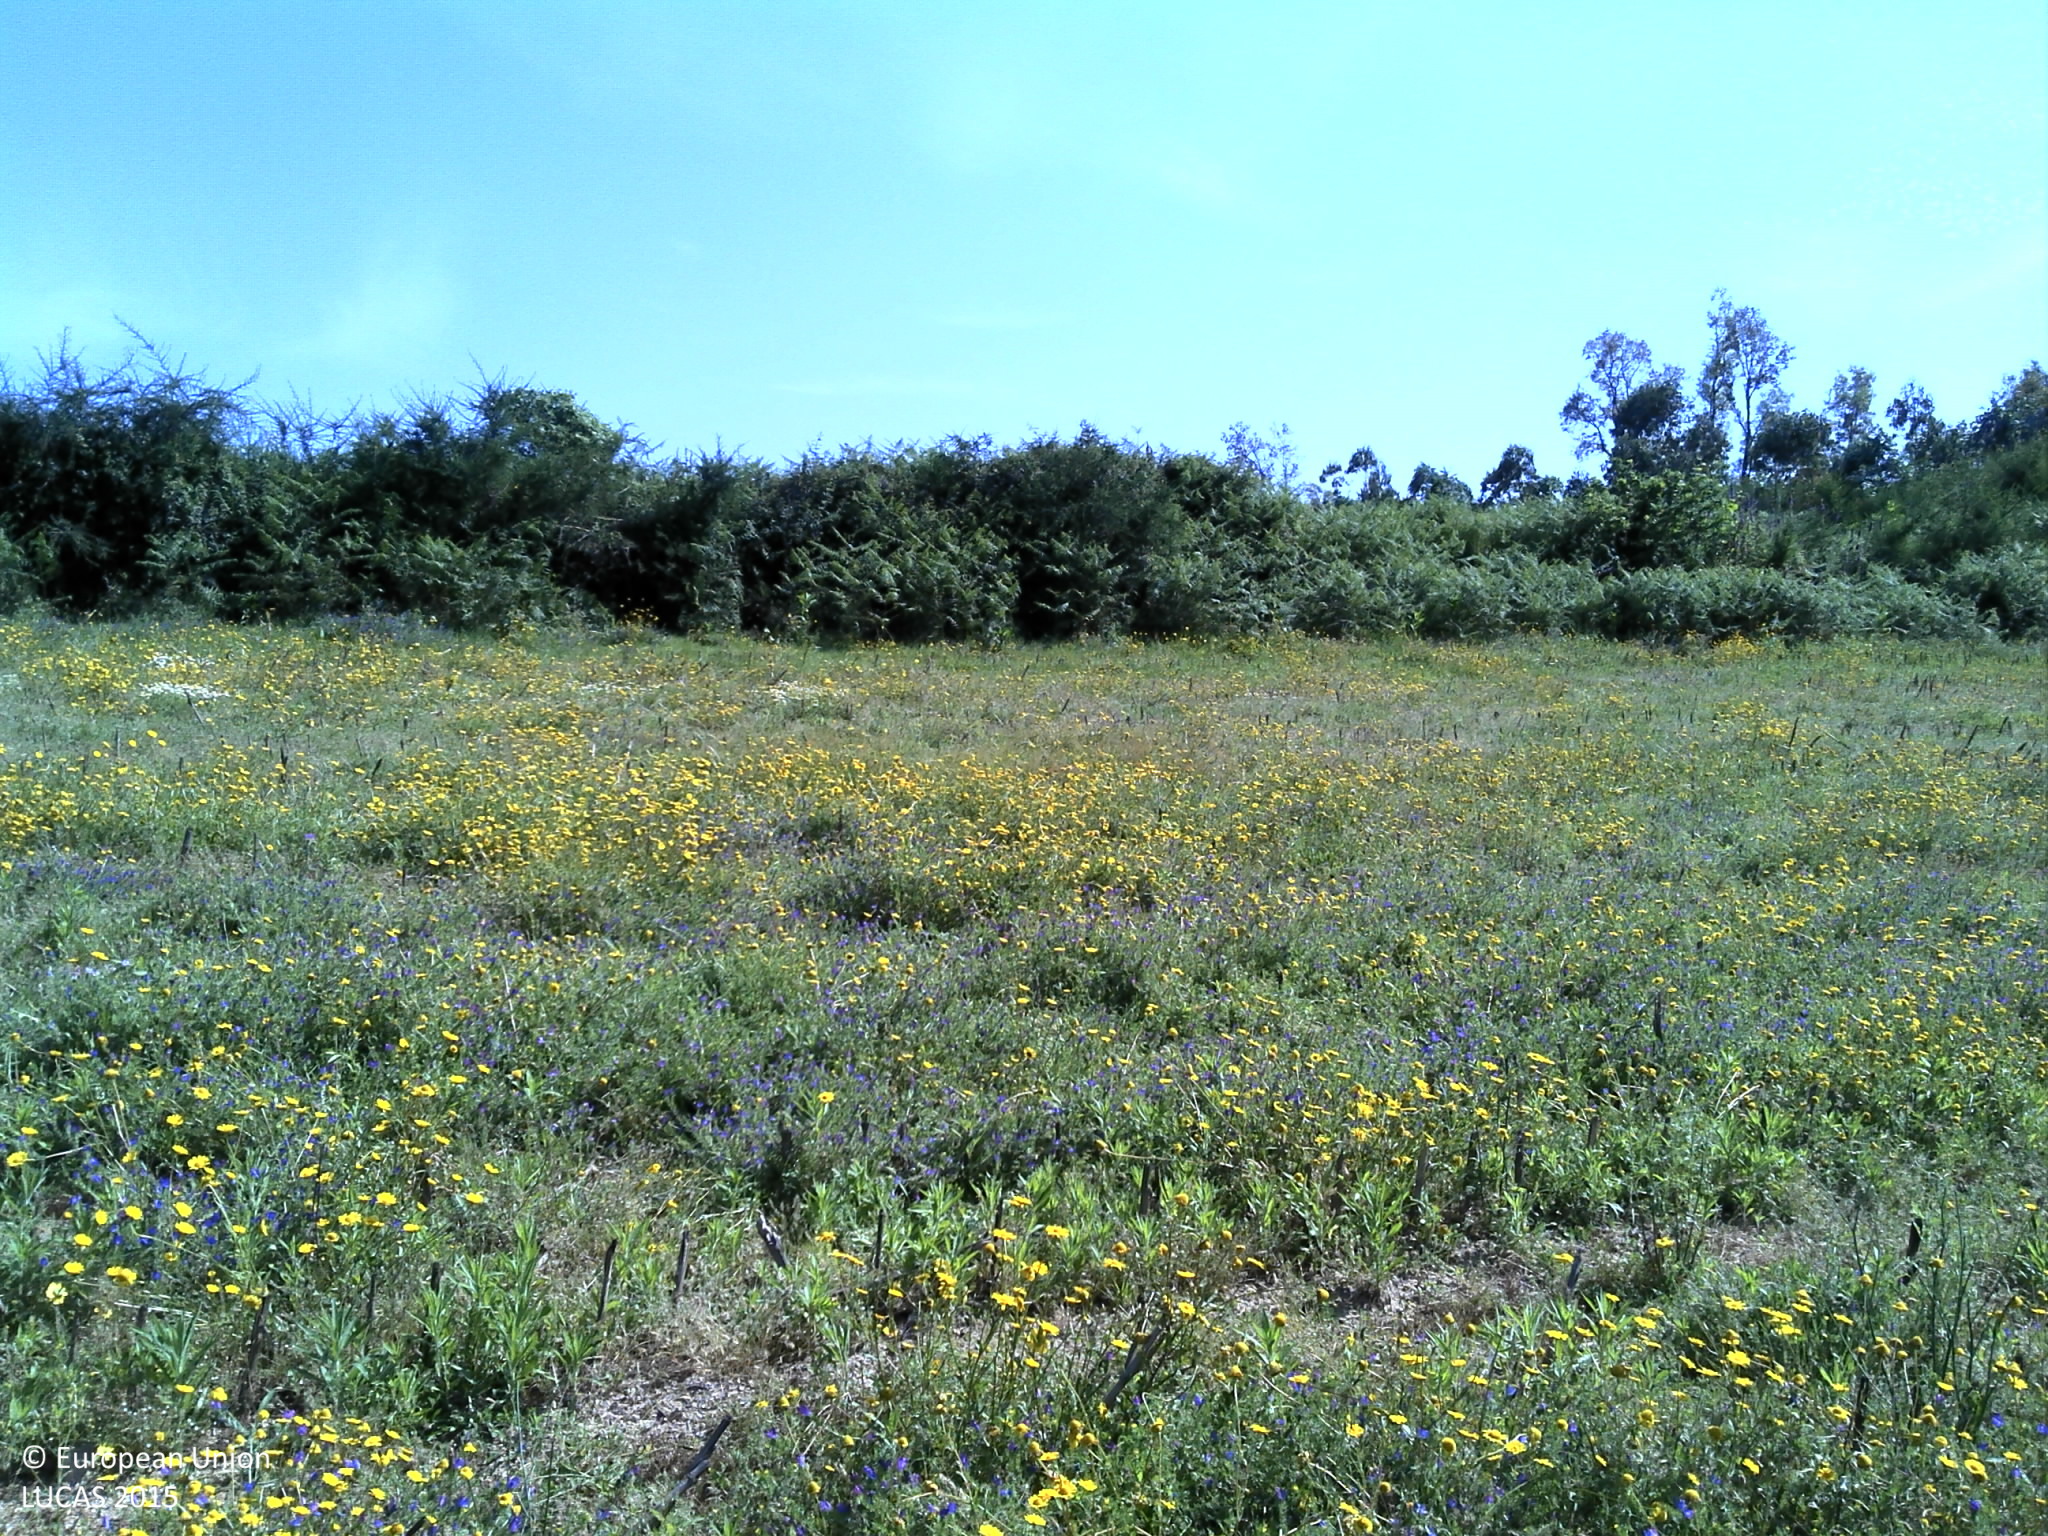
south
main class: Grassland
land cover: Grassland without tree/shrub cover
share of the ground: 50 - 75 %
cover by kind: herbaceous plants 95 %, unconsolidated bare surface 5 %
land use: Agriculture (excluding fallow land and kitchen gardens)
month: May
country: PT
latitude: 41.3570
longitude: -8.5011
